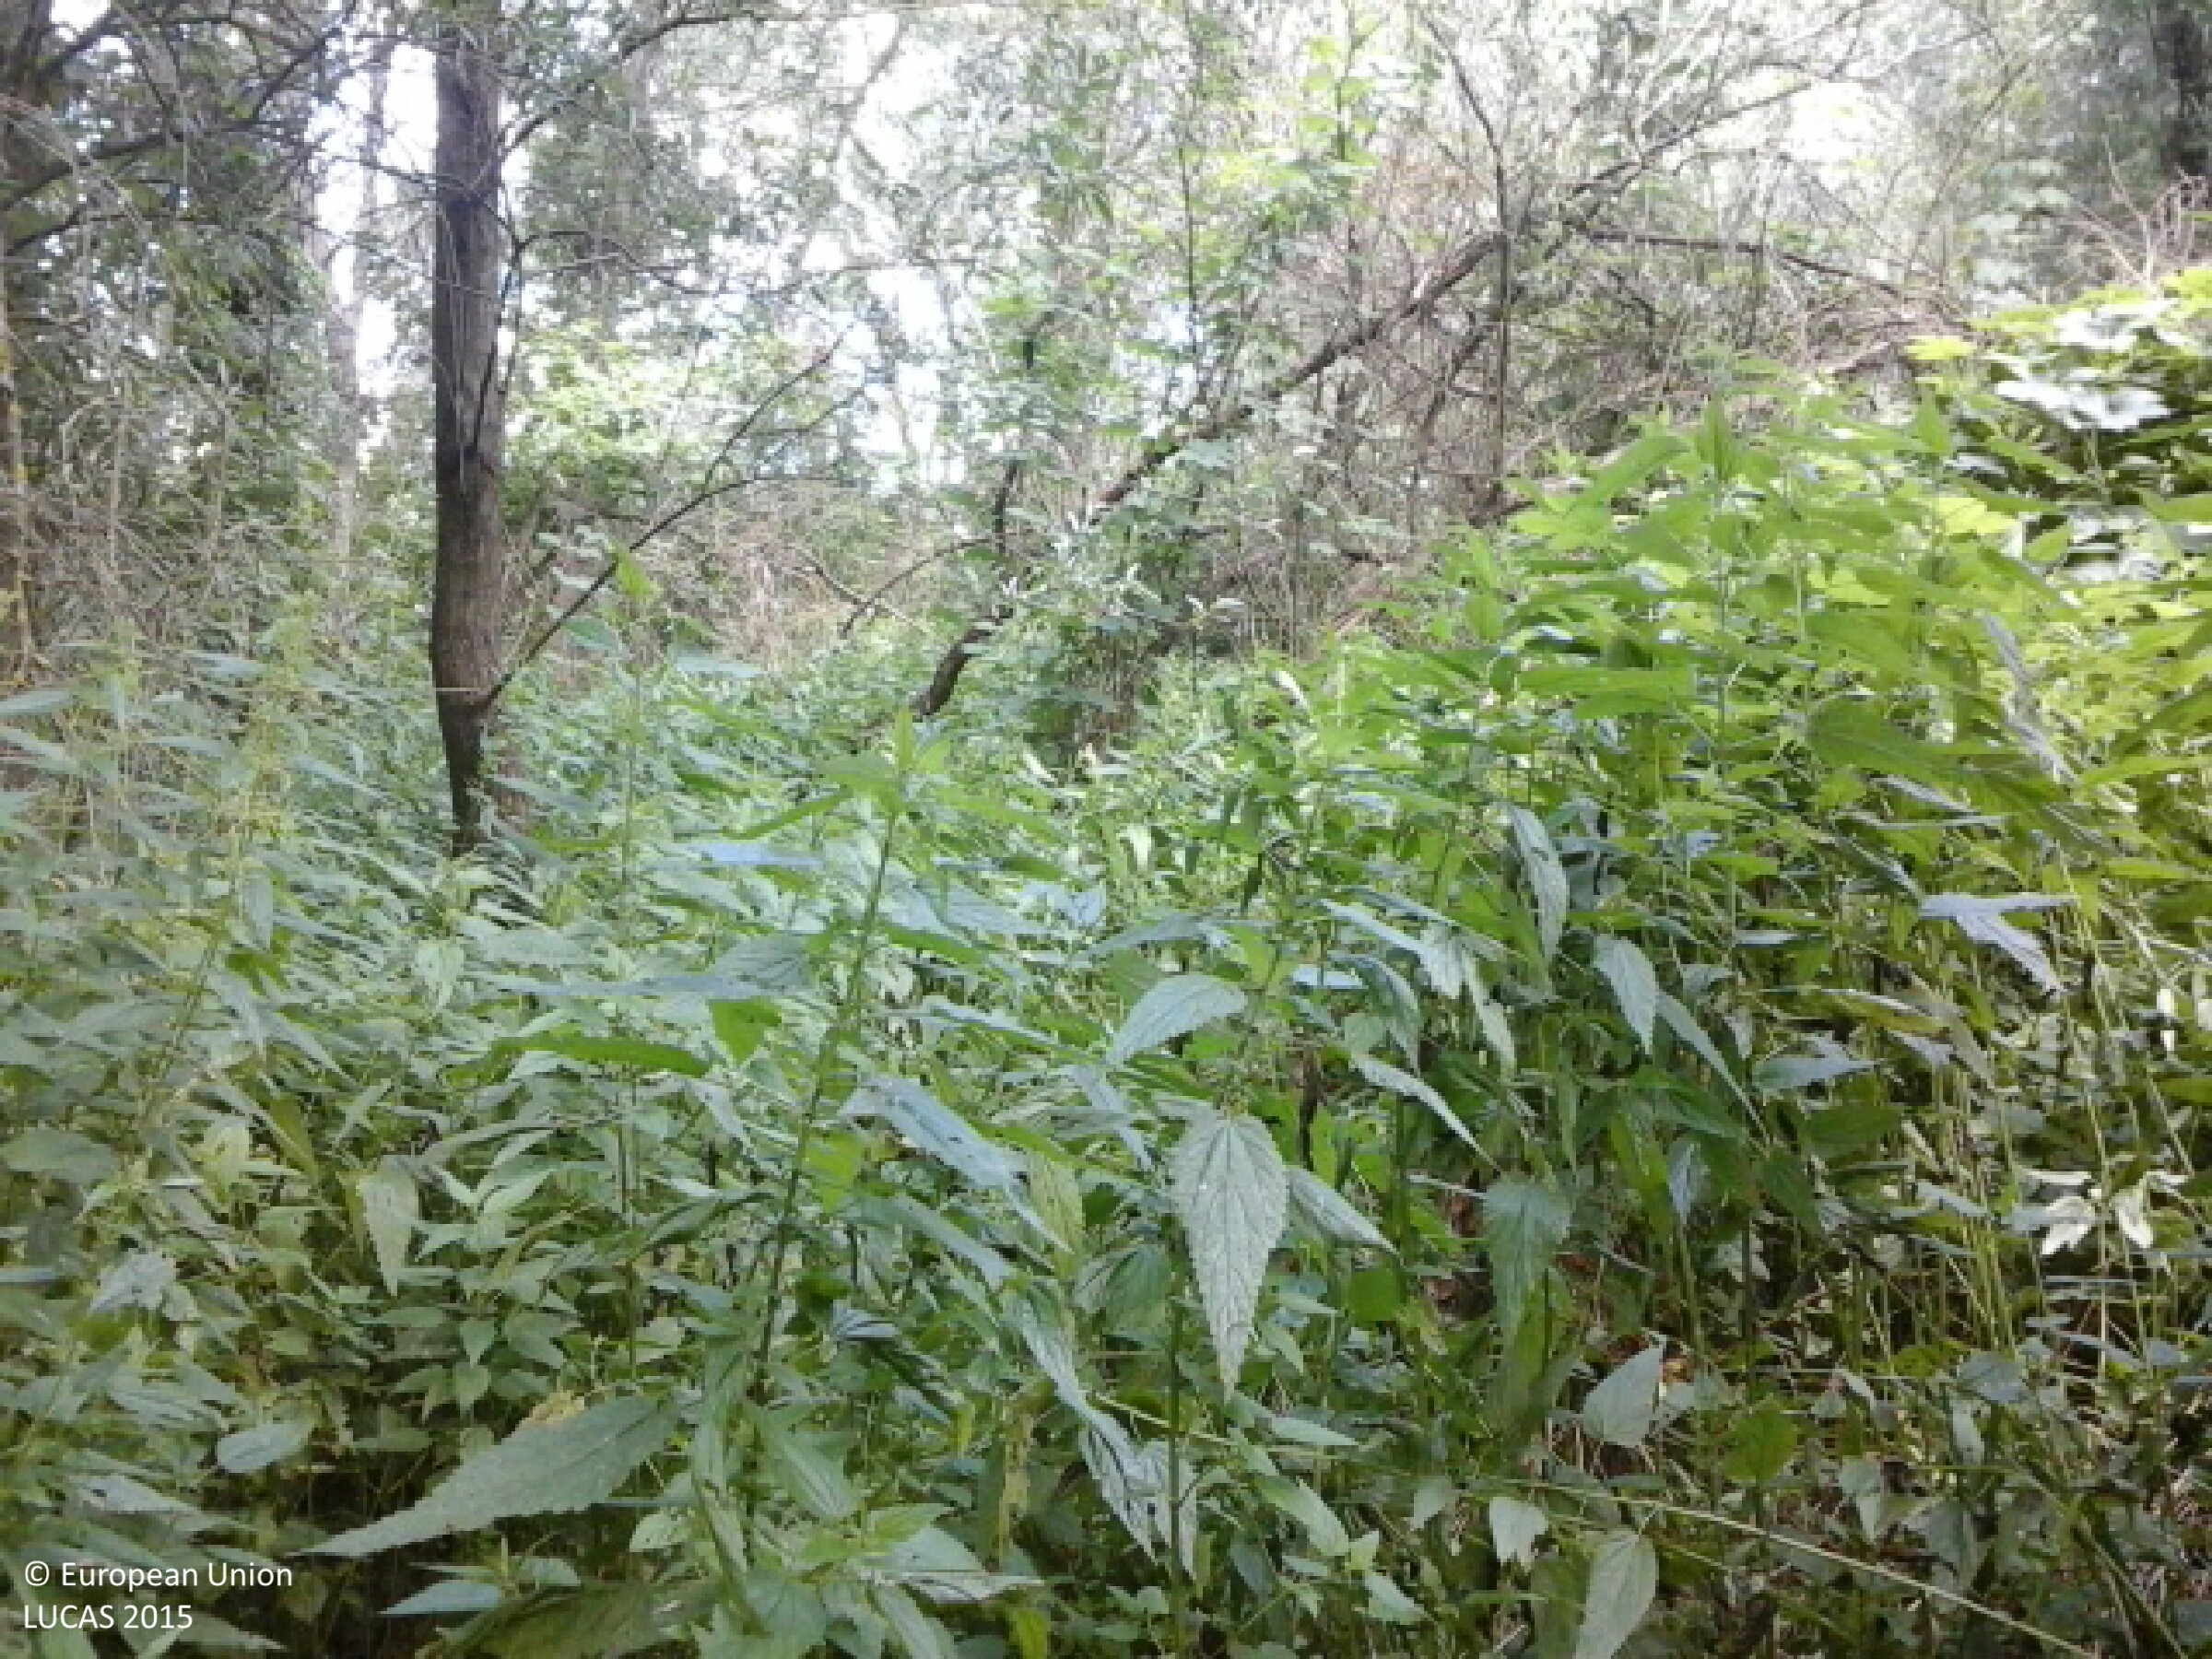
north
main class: Woodland
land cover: Broadleaved woodland
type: floodplain forest
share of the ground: > 75 %
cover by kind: broadleaved forest trees 100 %
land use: Forestry
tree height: > 5 m
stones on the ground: < 10 %
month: July
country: HU
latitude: 48.3067
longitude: 22.0399
